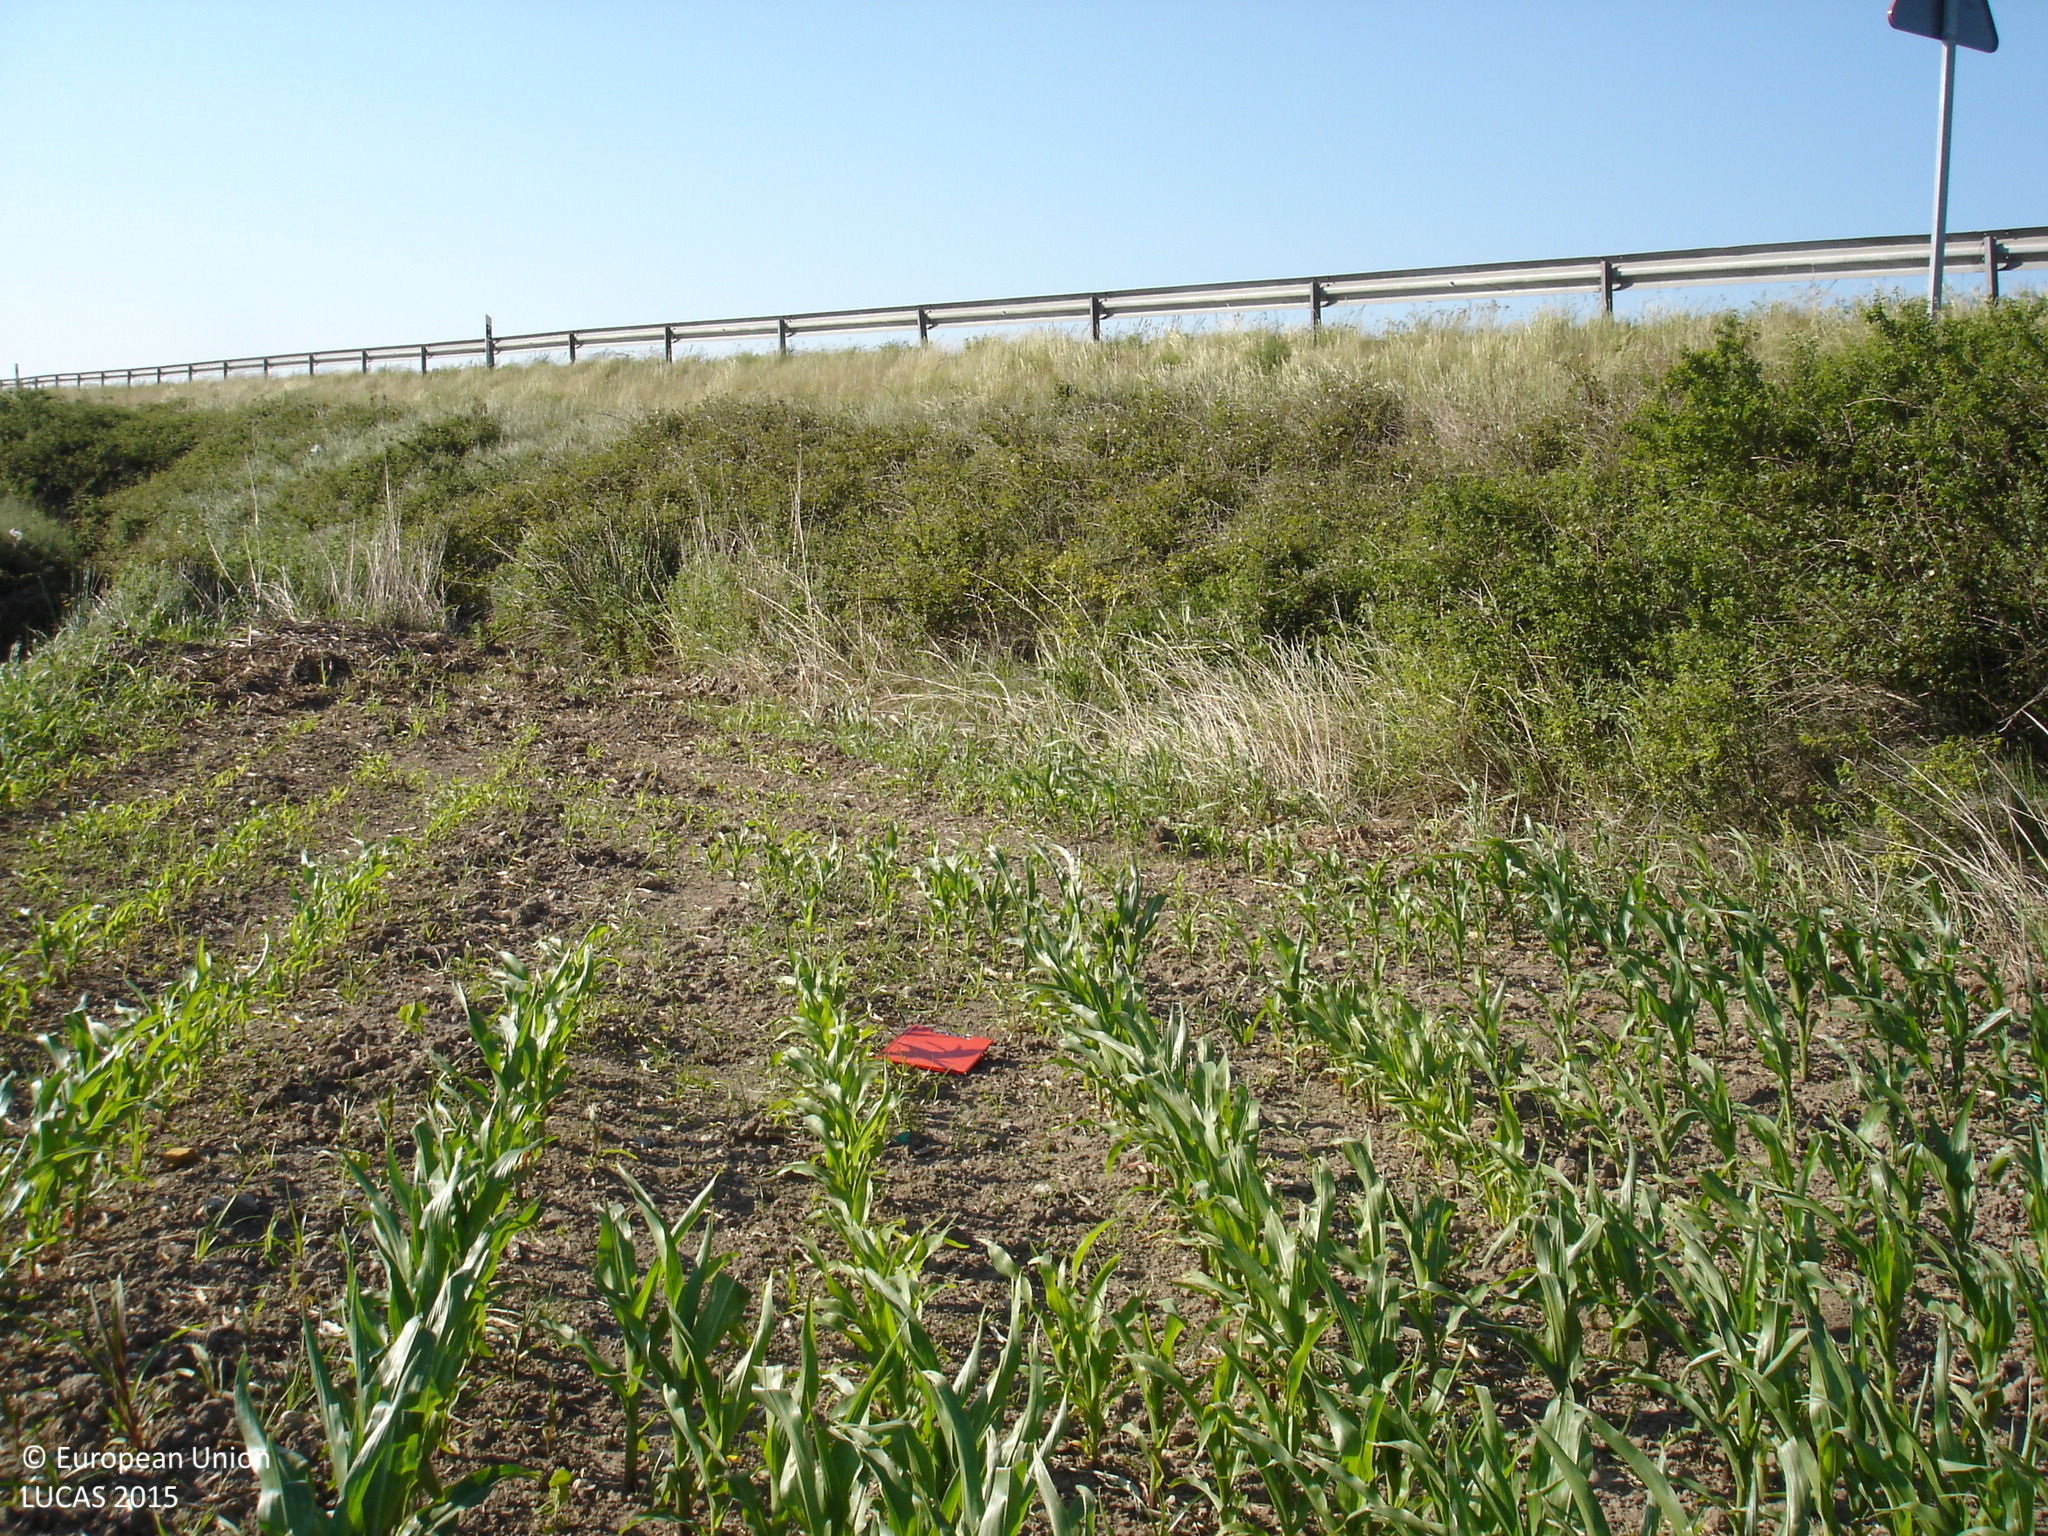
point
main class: Cropland
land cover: Maize
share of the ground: 25 - 50 %
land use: Agriculture (excluding fallow land and kitchen gardens)
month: May
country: ES
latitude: 42.2826
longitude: 2.9686
